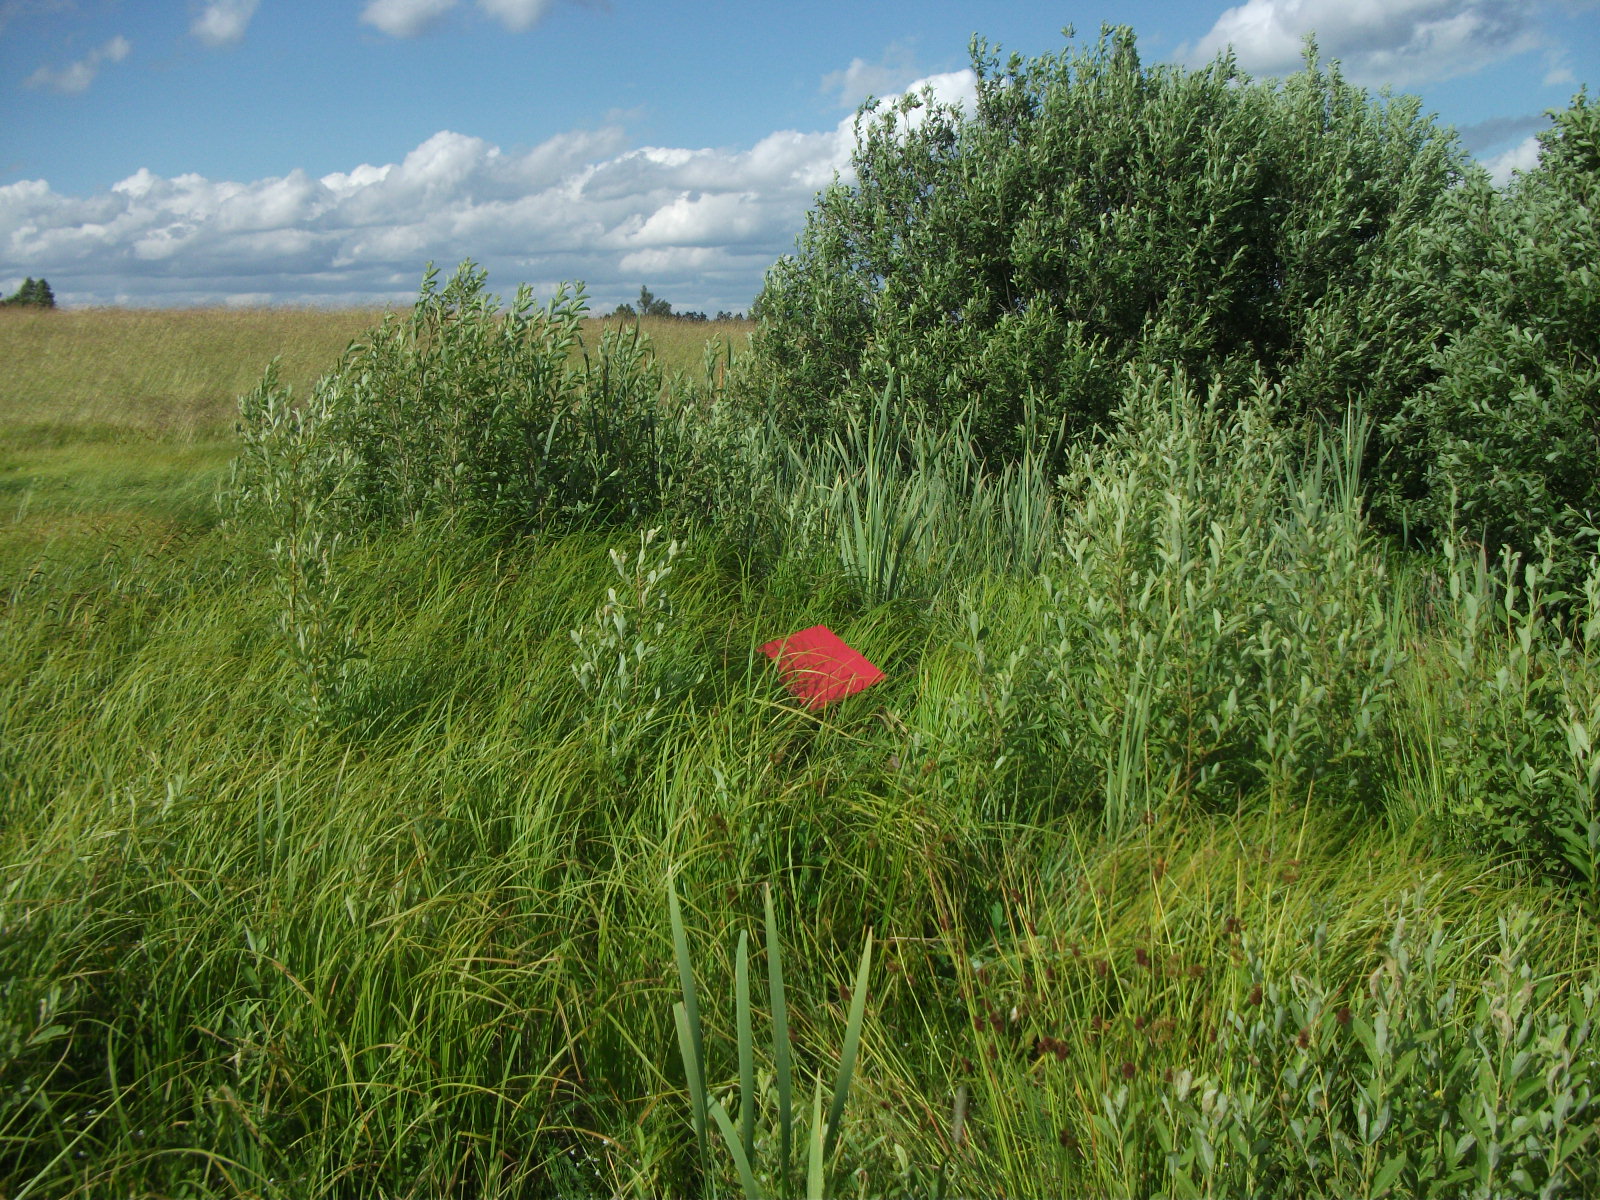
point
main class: Woodland
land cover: Broadleaved woodland
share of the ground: 50 - 75 %
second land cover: Spontaneously vegetated surfaces
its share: 50 - 75 %
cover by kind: broadleaved forest trees 50 %, shrubs 30 %, herbaceous plants 20 %
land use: Agriculture (excluding fallow land and kitchen gardens)
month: July
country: LV
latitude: 57.1650
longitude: 25.9539
